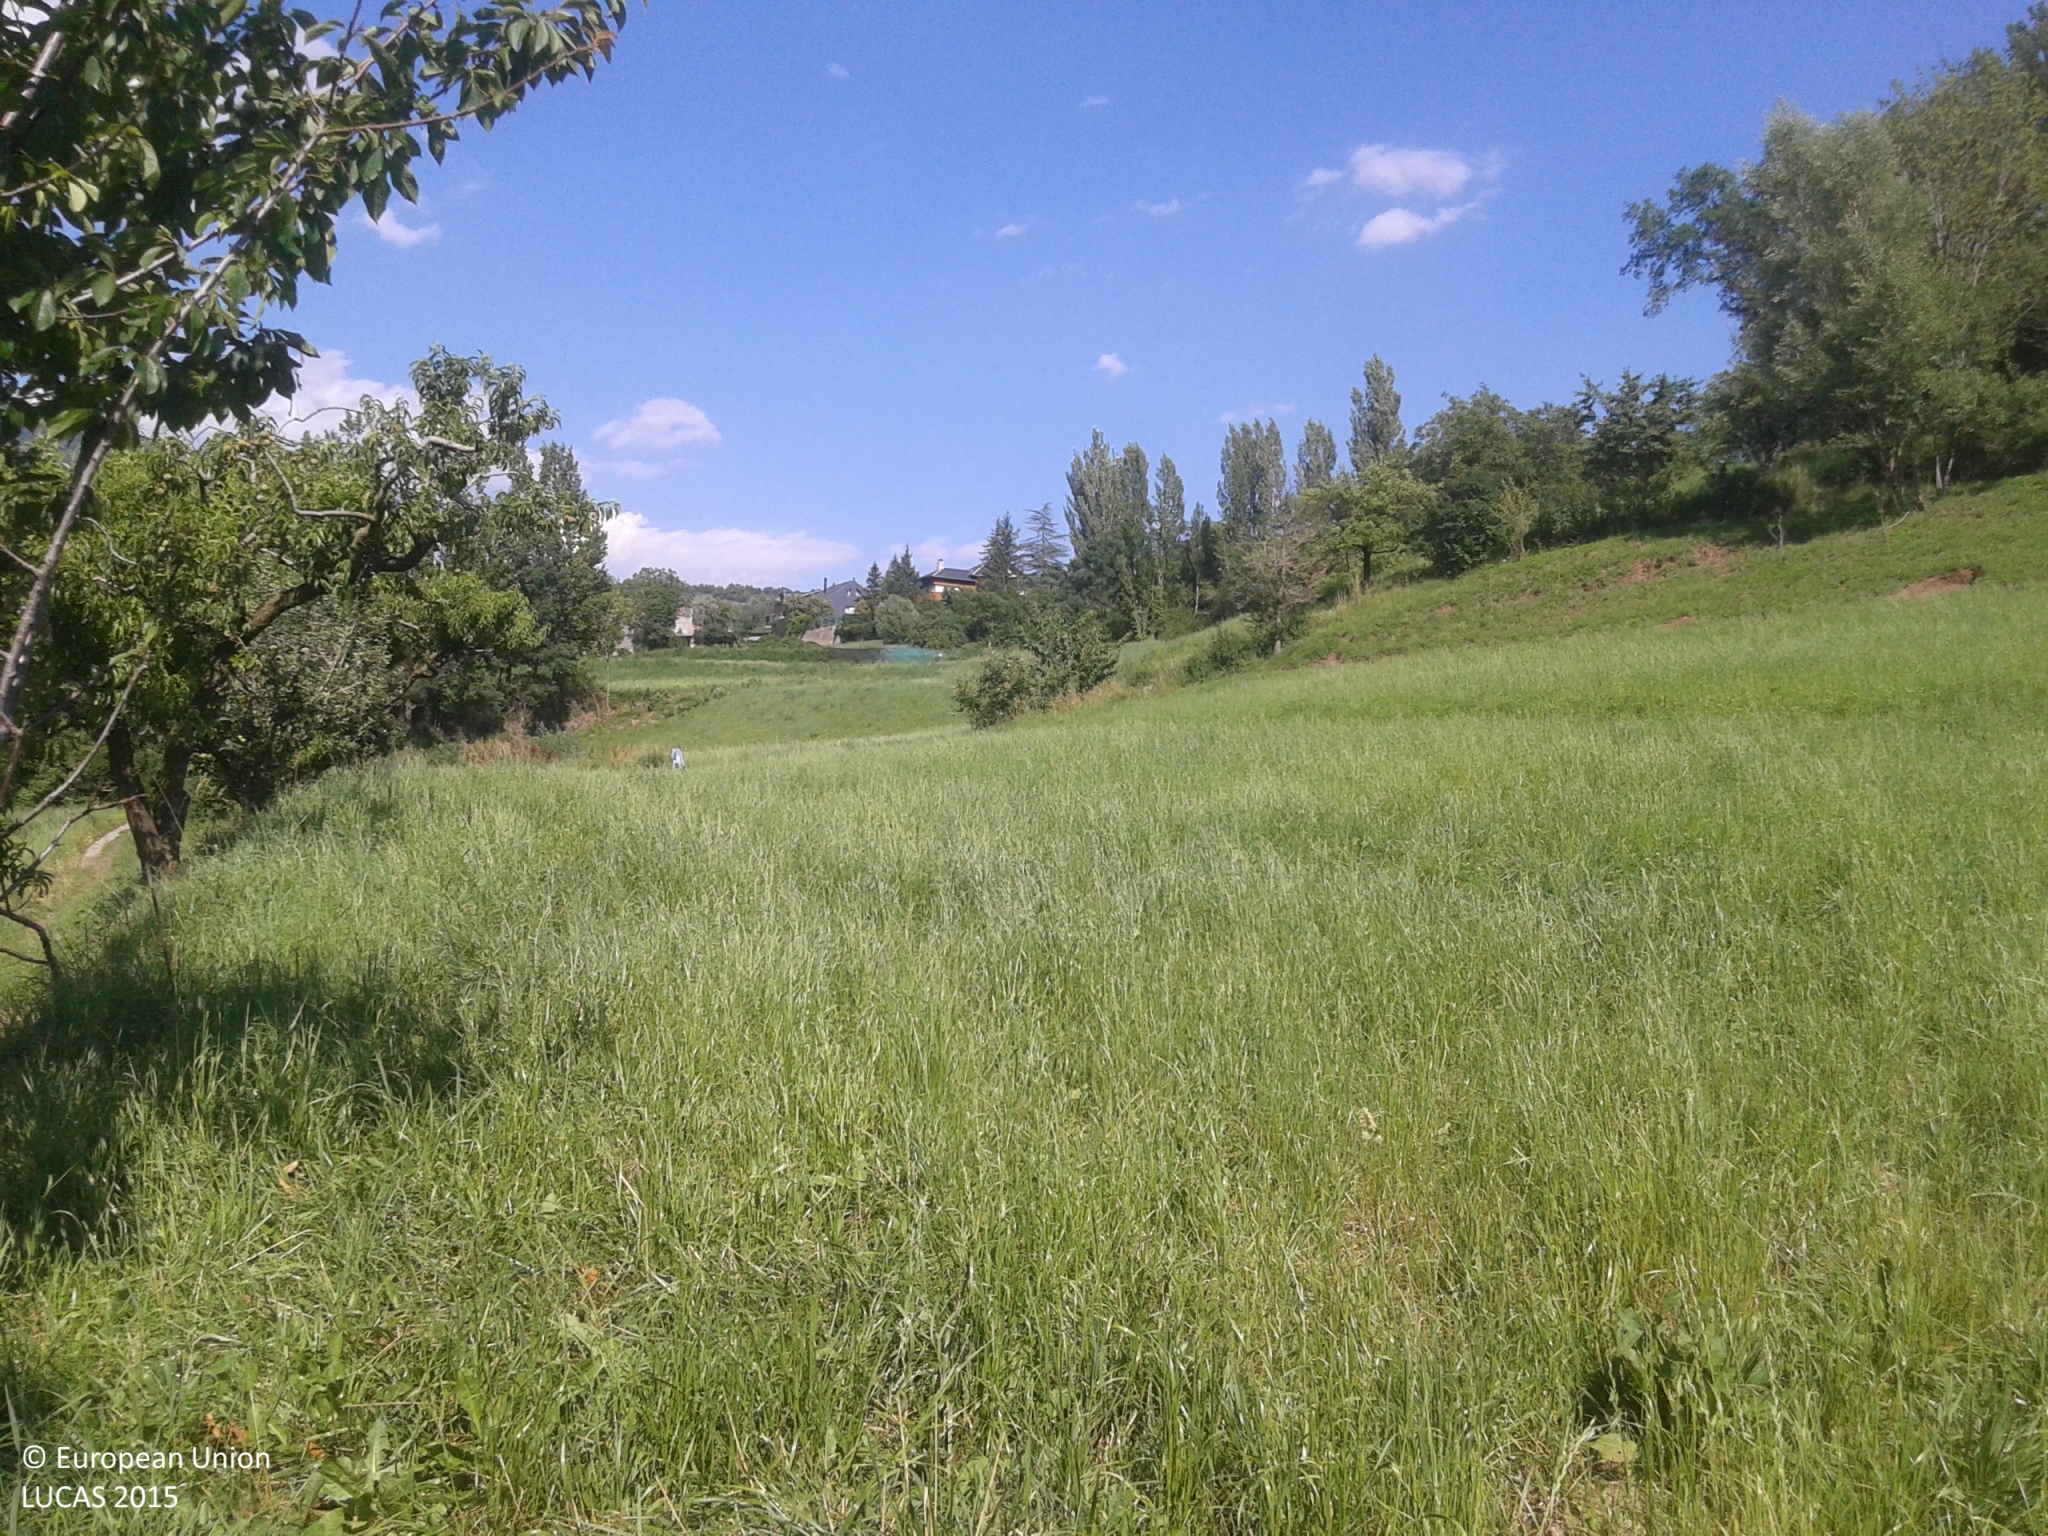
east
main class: Grassland
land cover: Grassland without tree/shrub cover
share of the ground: > 75 %
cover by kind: herbaceous plants 100 %
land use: Agriculture (excluding fallow land and kitchen gardens)
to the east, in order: Grassland without tree/shrub cover; Fences; Grassland without tree/shrub cover; Artificial constructions in urban areas; Grass margins; Ditches and canals; Groves; Shrubland without tree cover; Grassland without tree/shrub cover; Shruby margins; Artificial constructions in urban areas
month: June
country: ES
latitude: 42.3507
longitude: 1.5003
